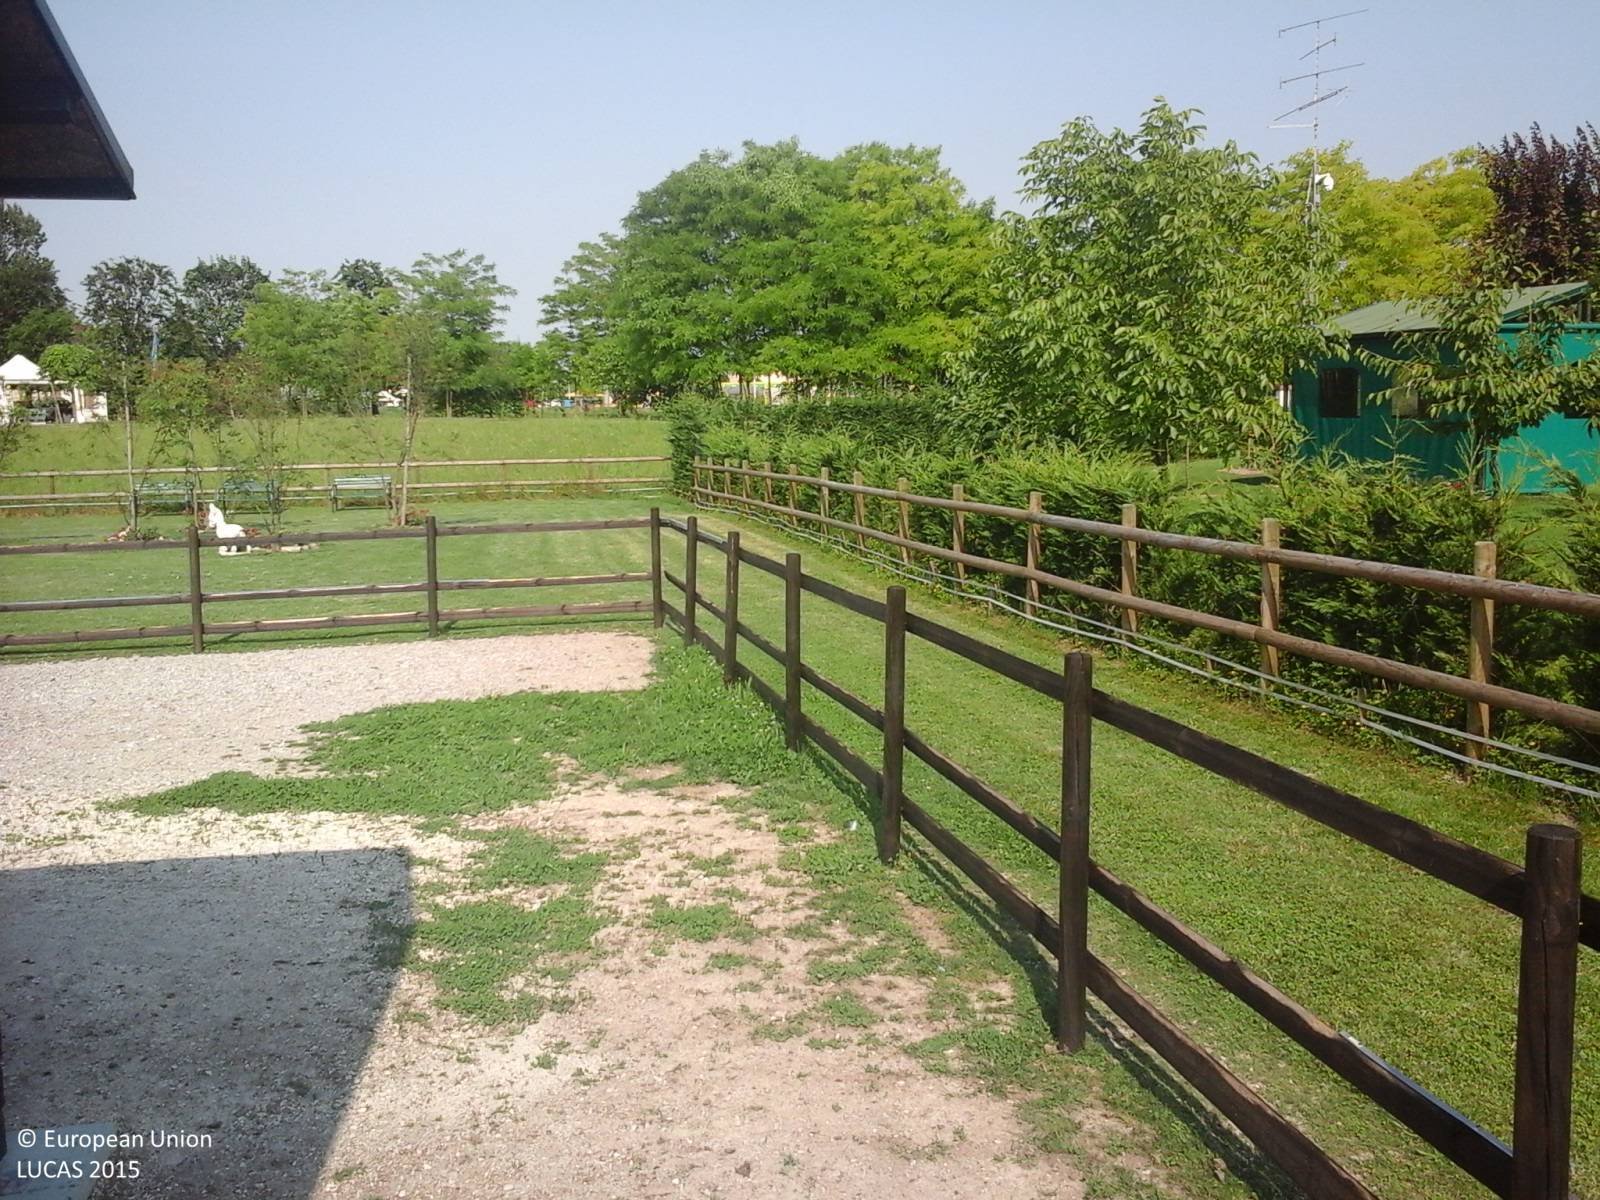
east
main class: Grassland
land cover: Grassland without tree/shrub cover
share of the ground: > 75 %
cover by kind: herbaceous plants 100 %
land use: Residential
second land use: Agriculture (excluding fallow land and kitchen gardens)
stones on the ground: < 10 %
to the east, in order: Grassland without tree/shrub cover; Artificial constructions in urban areas; Other bare soil; Fences; Grassland without tree/shrub cover; Fences; Conifer hedges; Grassland with sparse tree/shrub cover; Conifer hedges; Fences; Grassland without tree/shrub cover; Broadleaved woodland; Spontaneously vegetated surfaces; Electric lines; Grass margins; Paved roads, cycling and walking lanes; Grass margins; Ditches and canals; Grassland with sparse tree/shrub cover; Soya; Grass margins; Electric lines; Ditches and canals; Grass margins; Paved roads, cycling and walking lanes; Grass margins; Ditches and canals; Electric lines; Soya; Artificial constructions in urban areas
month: June
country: IT
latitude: 45.8700
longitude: 12.5602
